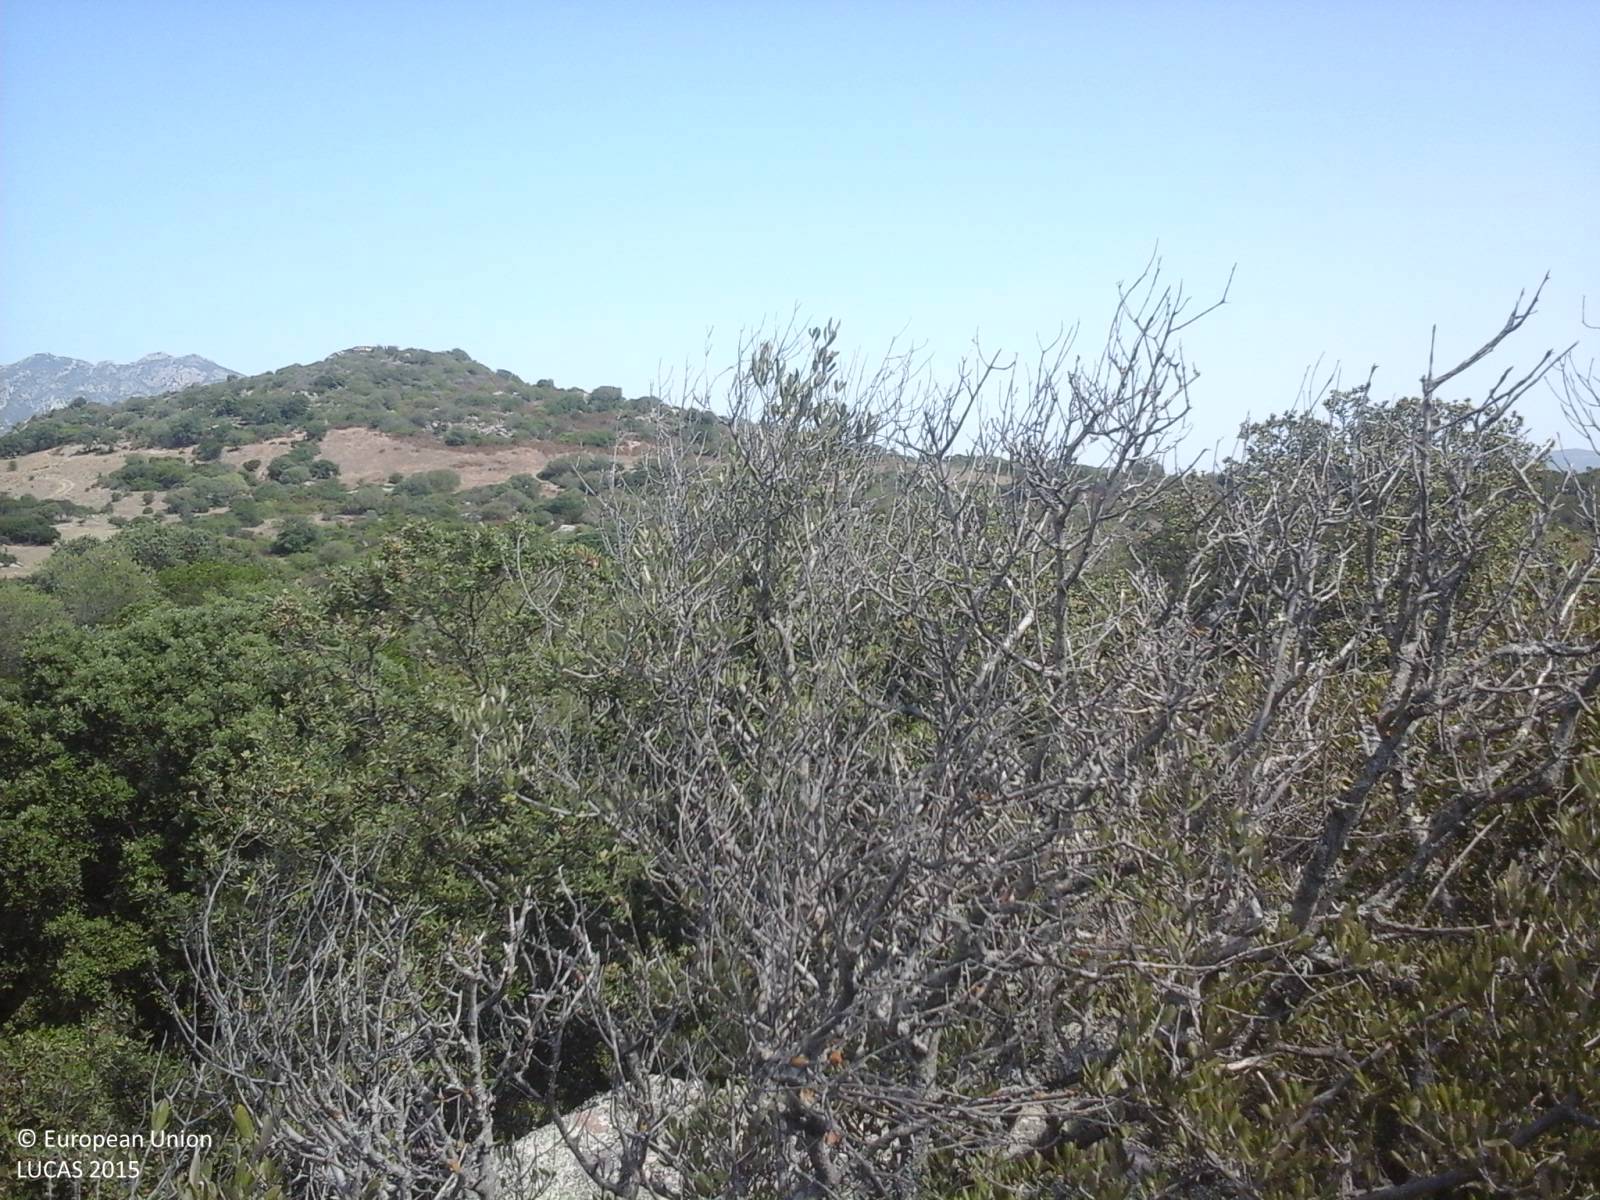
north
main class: Woodland
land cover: Broadleaved woodland
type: broadleaved evergreen forest
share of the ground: > 75 %
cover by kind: broadleaved forest trees 95 %, consolidated bare surface 5 %
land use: Semi-natural and natural areas not in use
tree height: > 5 m
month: July
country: IT
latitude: 40.8990
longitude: 9.4211
